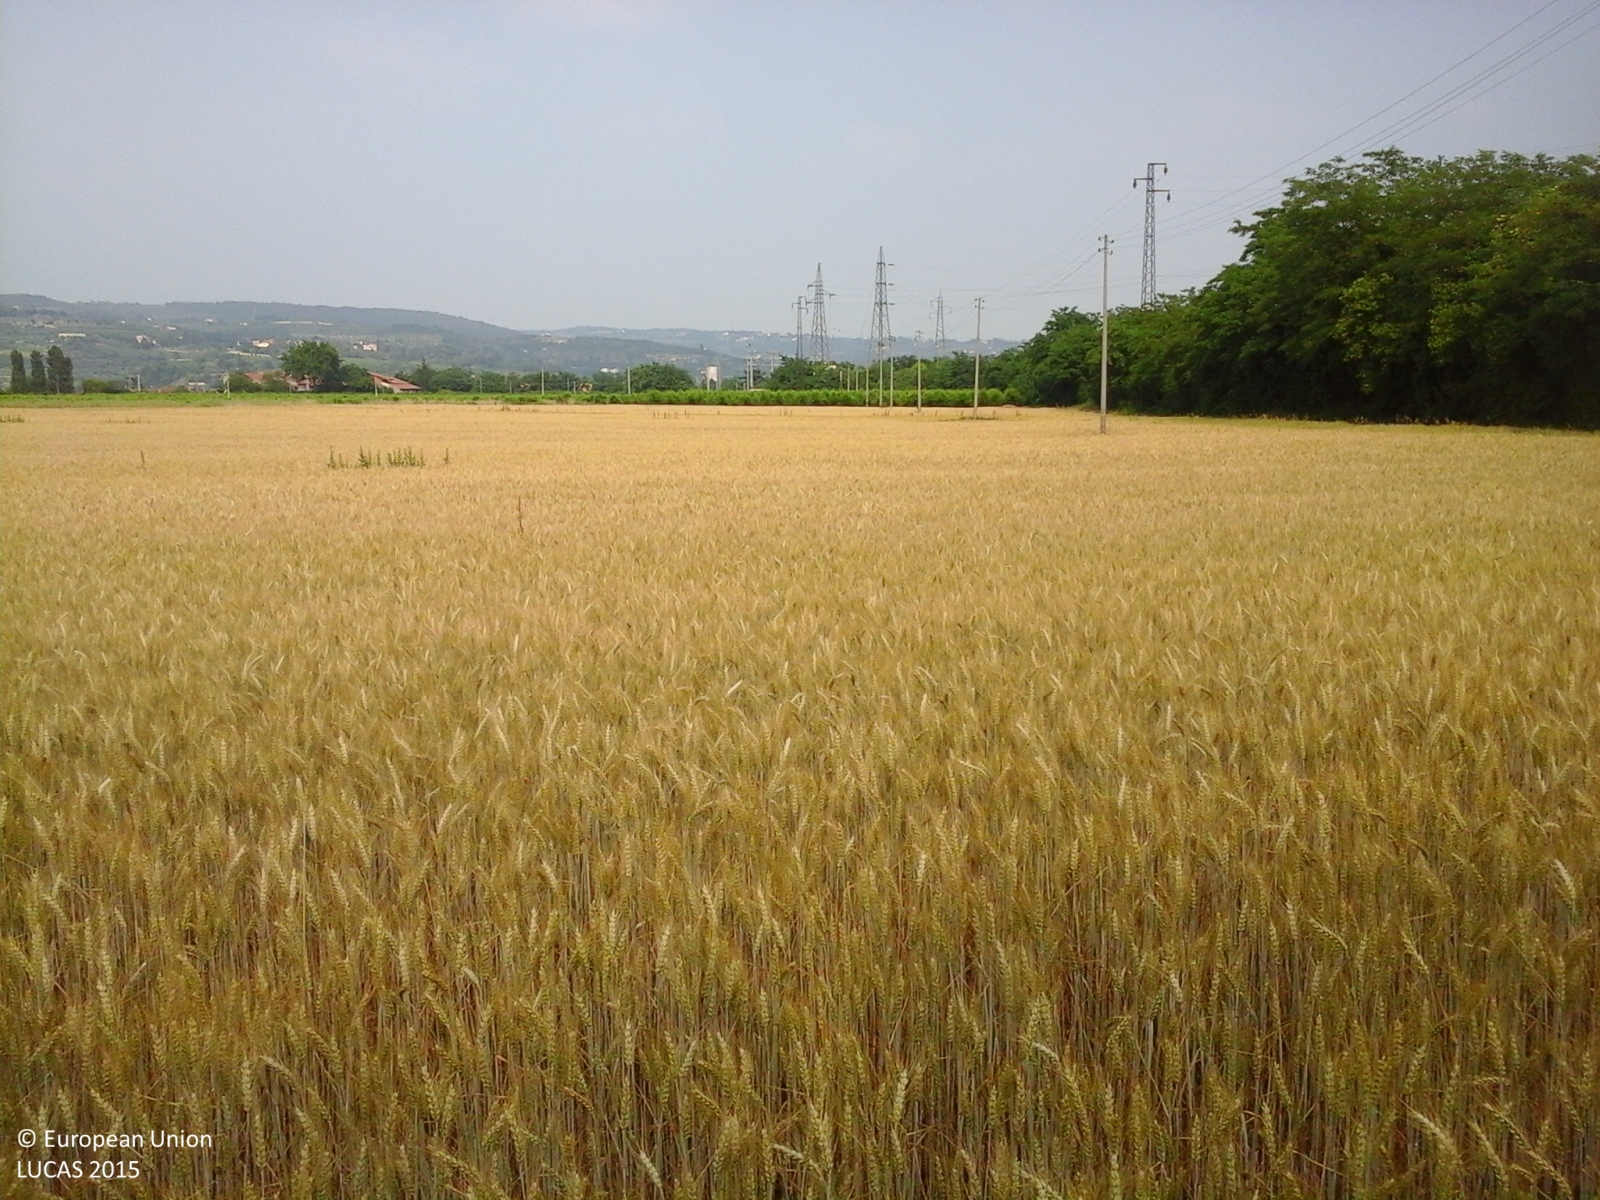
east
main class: Cropland
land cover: Common wheat
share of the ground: > 75 %
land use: Agriculture (excluding fallow land and kitchen gardens)
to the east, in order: Common wheat; Electric lines; Common wheat; Tracks; Other fruit trees and berries
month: June
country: IT
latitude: 45.4642
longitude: 10.9320
